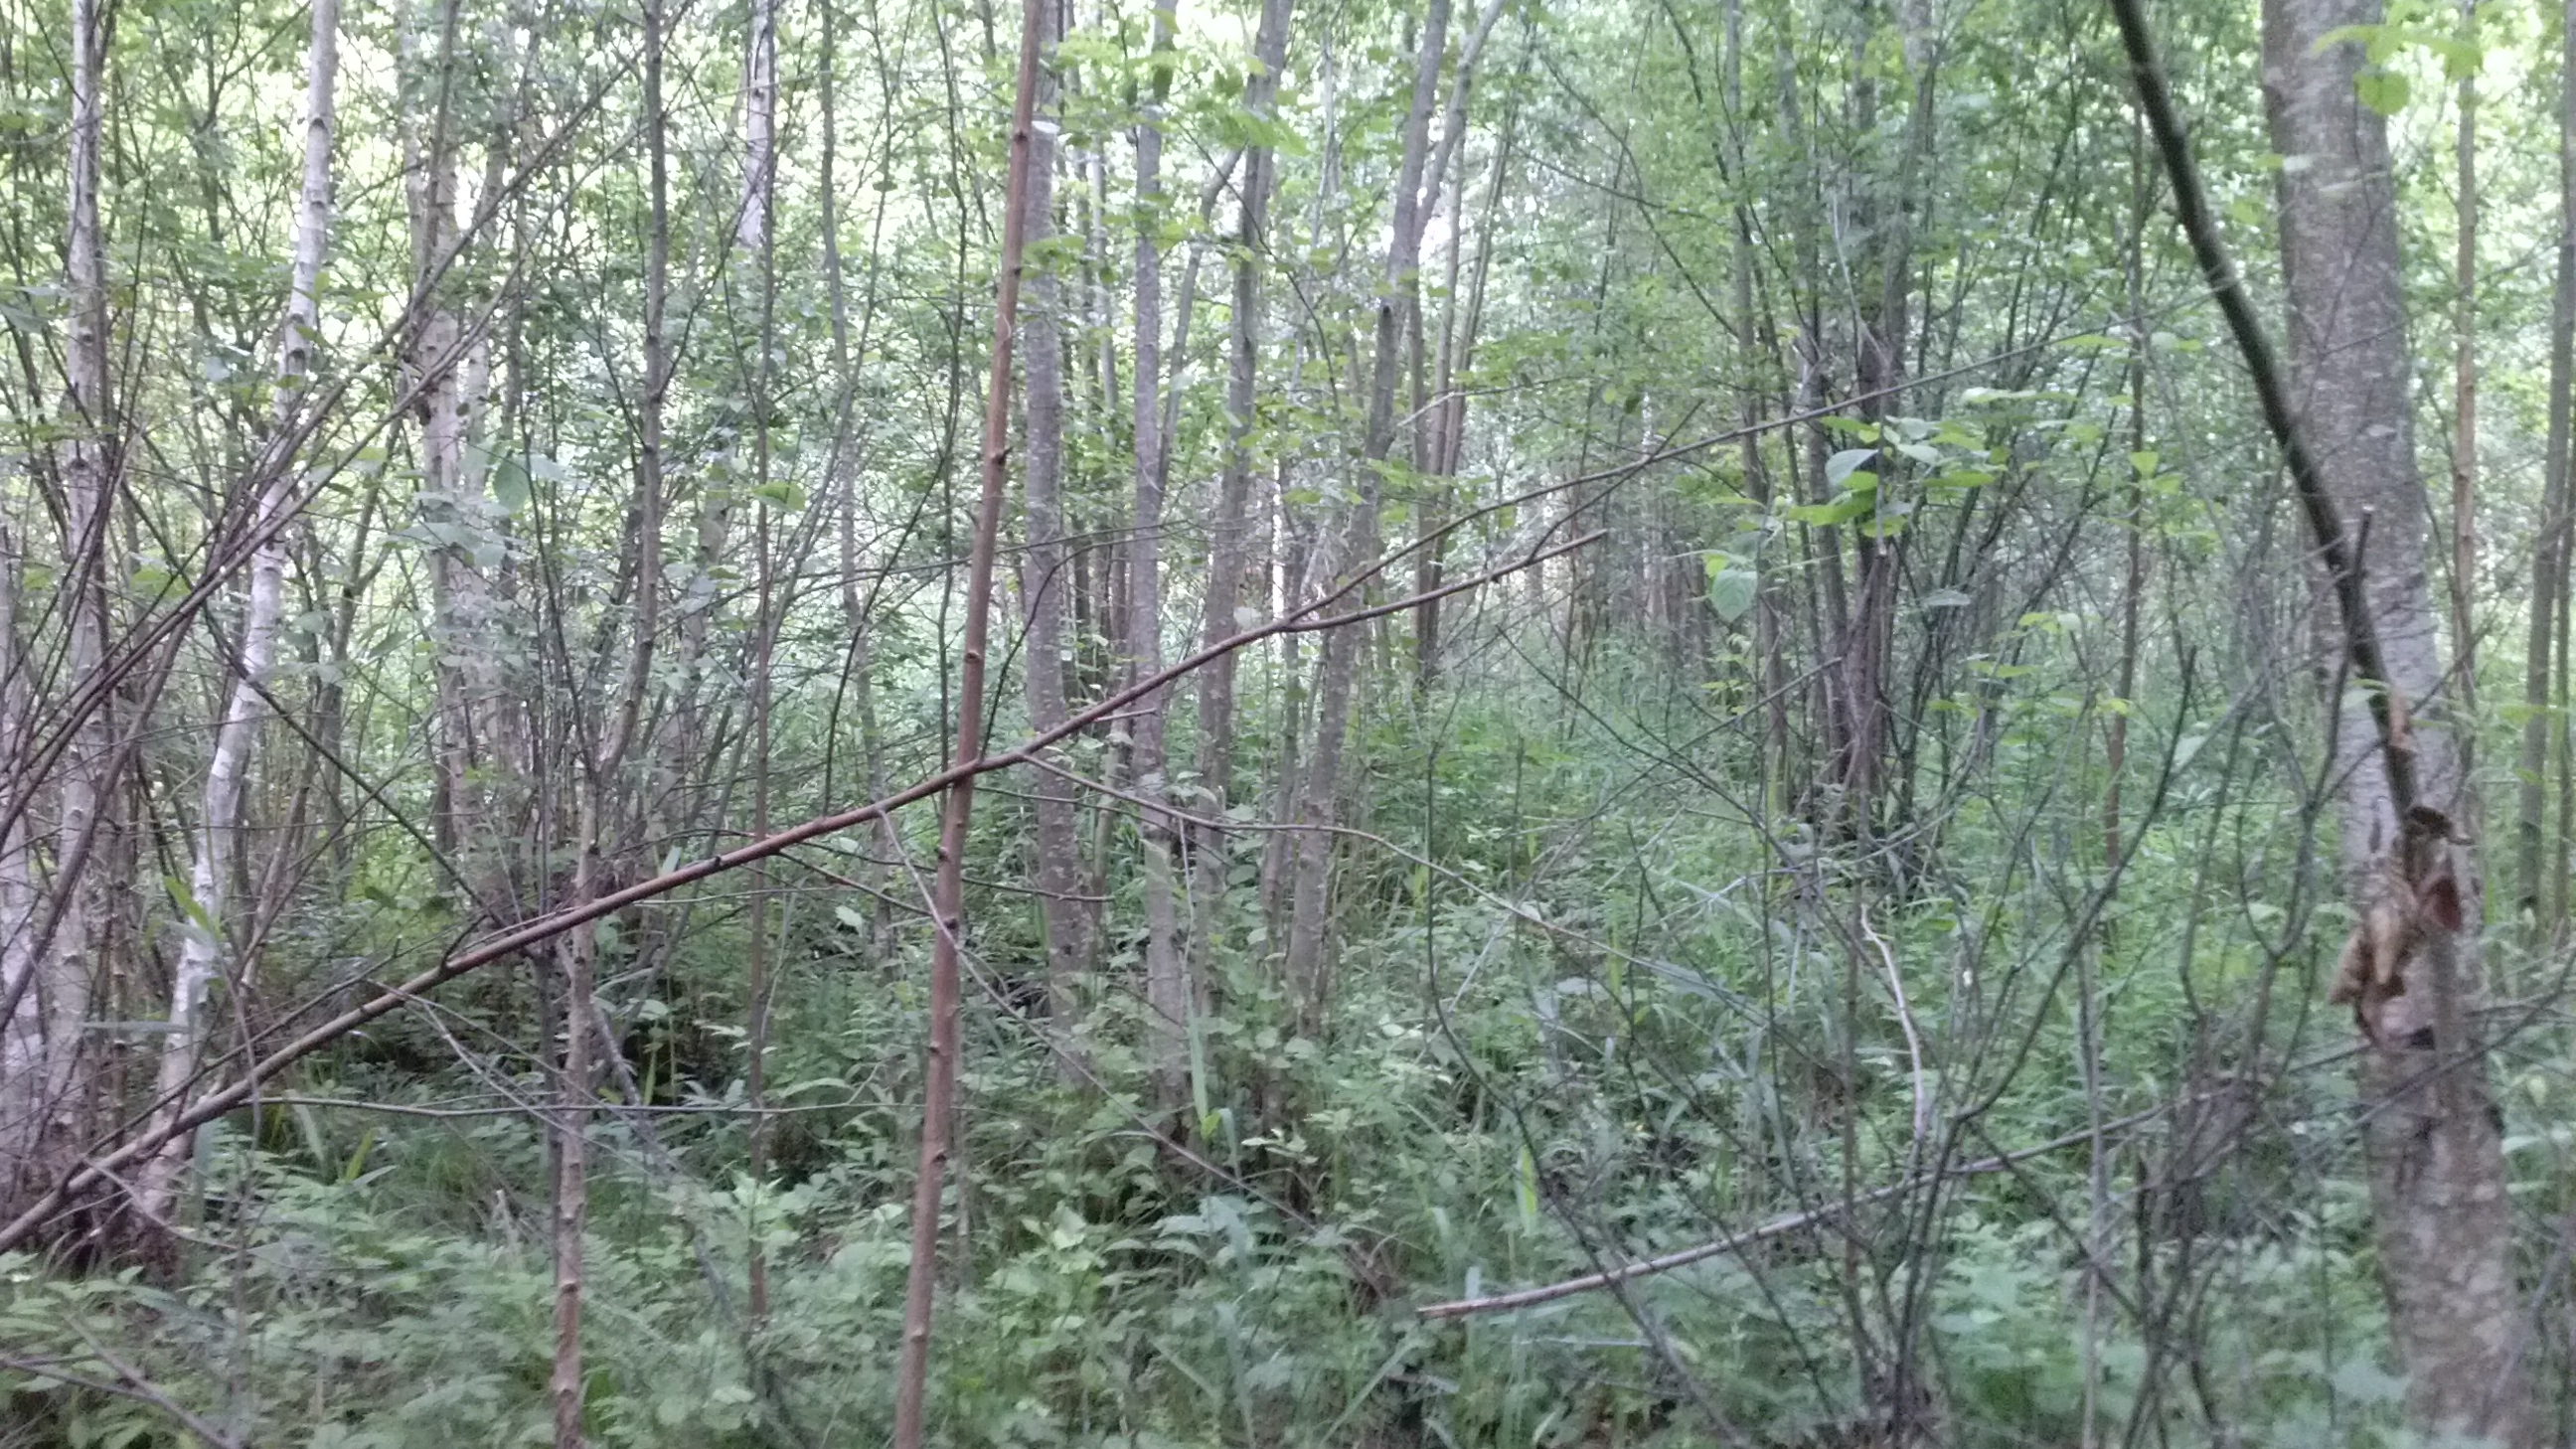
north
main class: Woodland
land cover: Broadleaved woodland
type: non-riverine alder, birch or aspen forest
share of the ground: > 75 %
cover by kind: broadleaved forest trees 80 %, herbaceous plants 15 %, shrubs 5 %
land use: Forestry
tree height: > 5 m
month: June
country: LV
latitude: 56.6082
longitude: 27.9354
